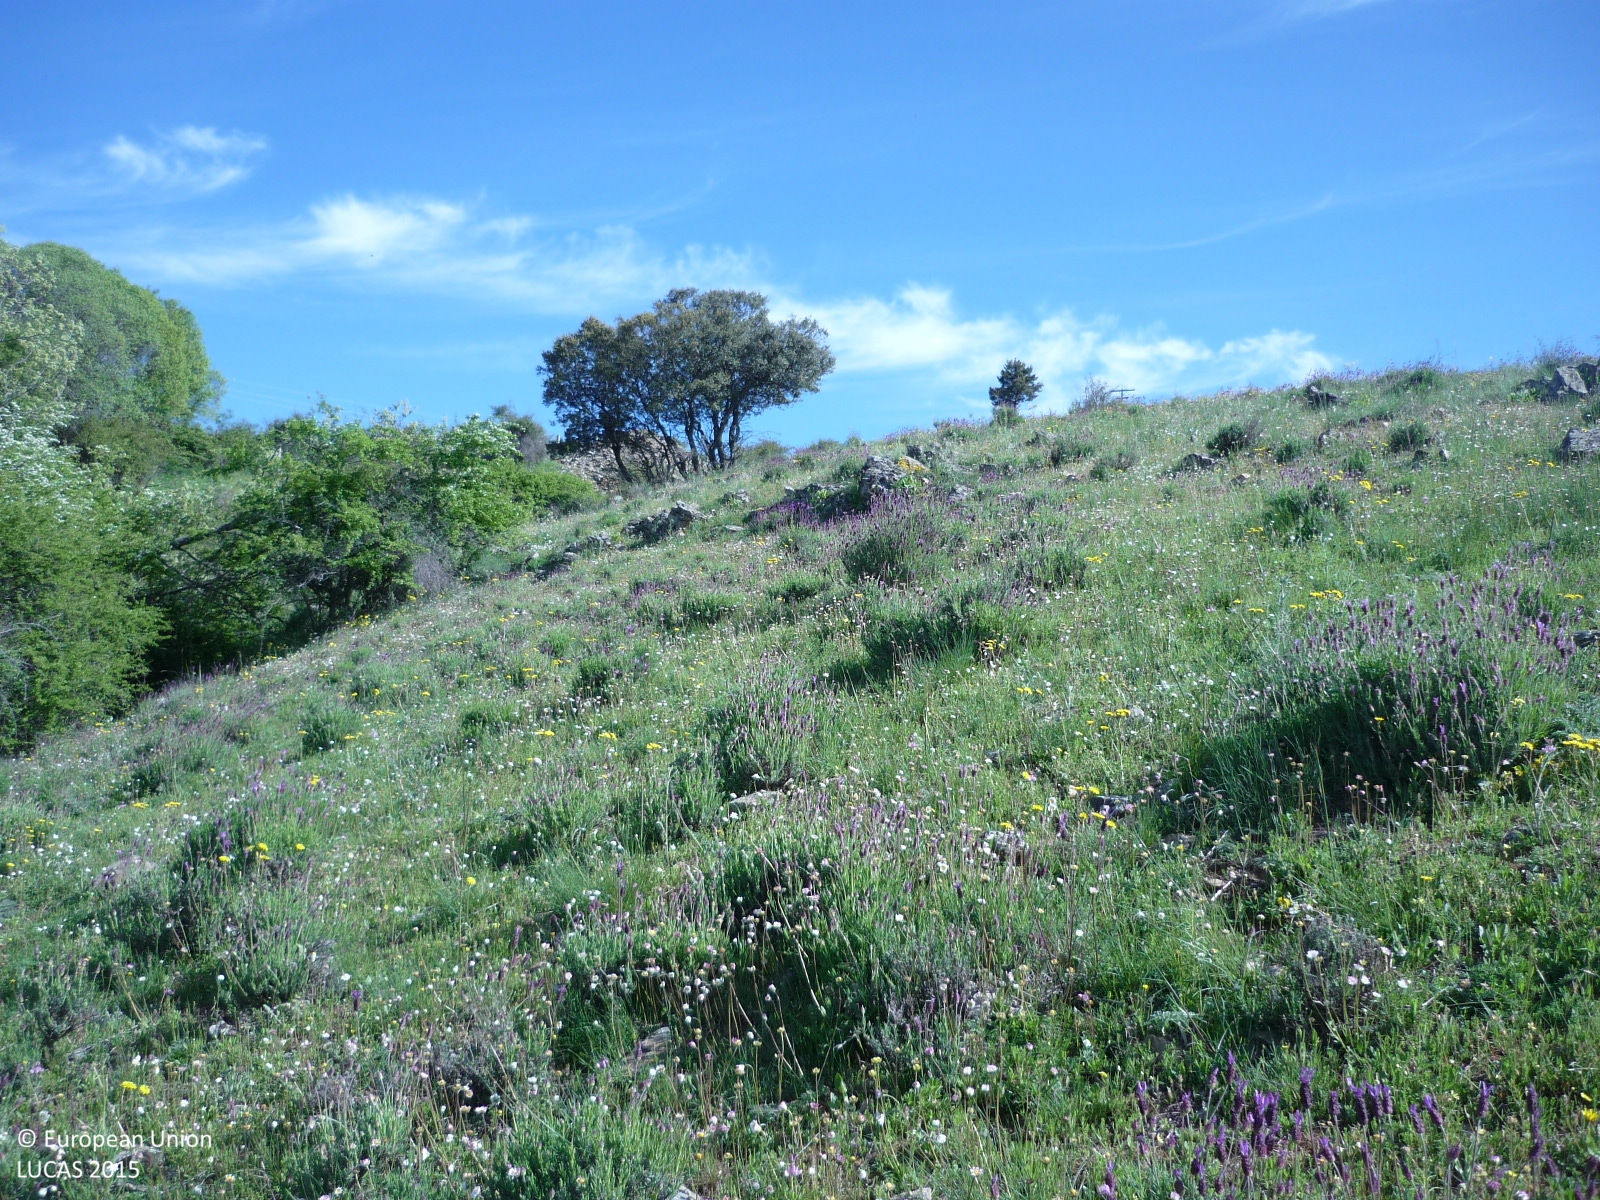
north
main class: Grassland
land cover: Grassland with sparse tree/shrub cover
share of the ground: > 75 %
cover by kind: herbaceous plants 85 %, shrubs 10 %, broadleaved forest trees 5 %
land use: Agriculture (excluding fallow land and kitchen gardens)
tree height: < 5 m
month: May
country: ES
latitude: 41.0280
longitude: -3.6628
